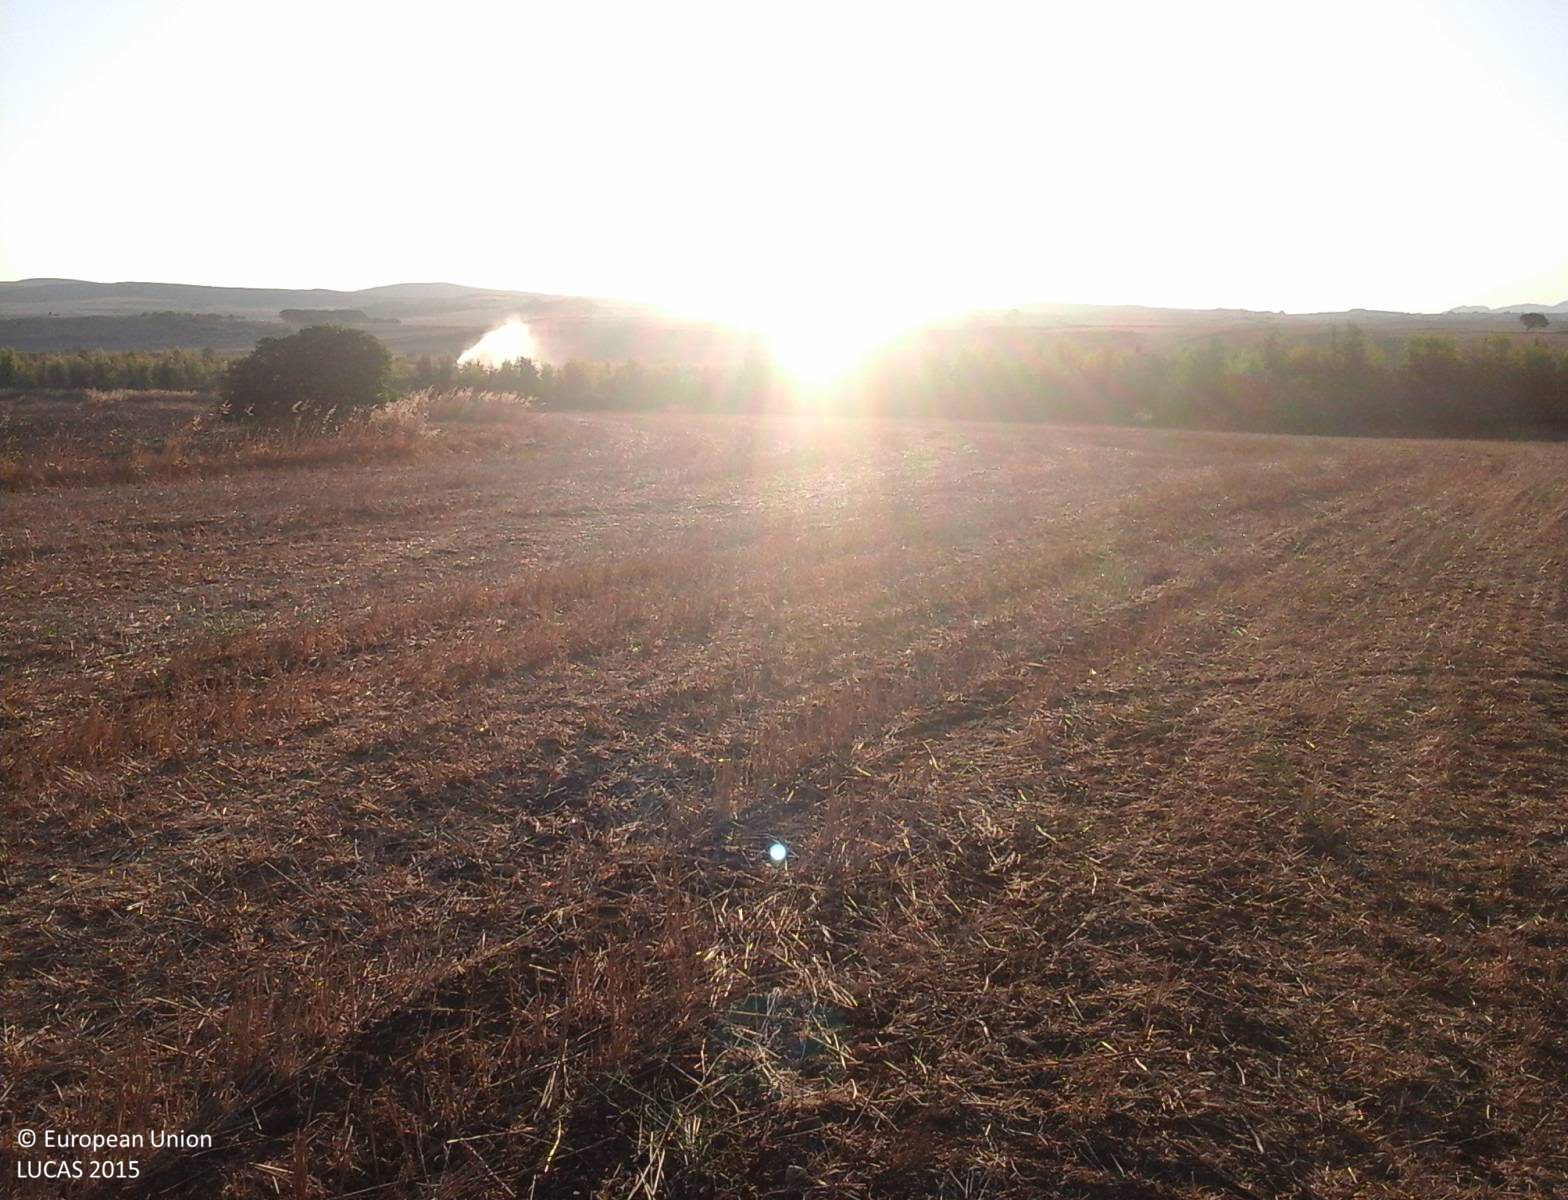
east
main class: Cropland
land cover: Durum wheat
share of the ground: > 75 %
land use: Agriculture (excluding fallow land and kitchen gardens)
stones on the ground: 10 - 25 %
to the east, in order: Durum wheat; Grass margins; Tracks; Grass margins; Fences; Broadleaved woodland; Fences; Mixed cereals for fodder
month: August
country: IT
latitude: 39.5725
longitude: 8.8543
